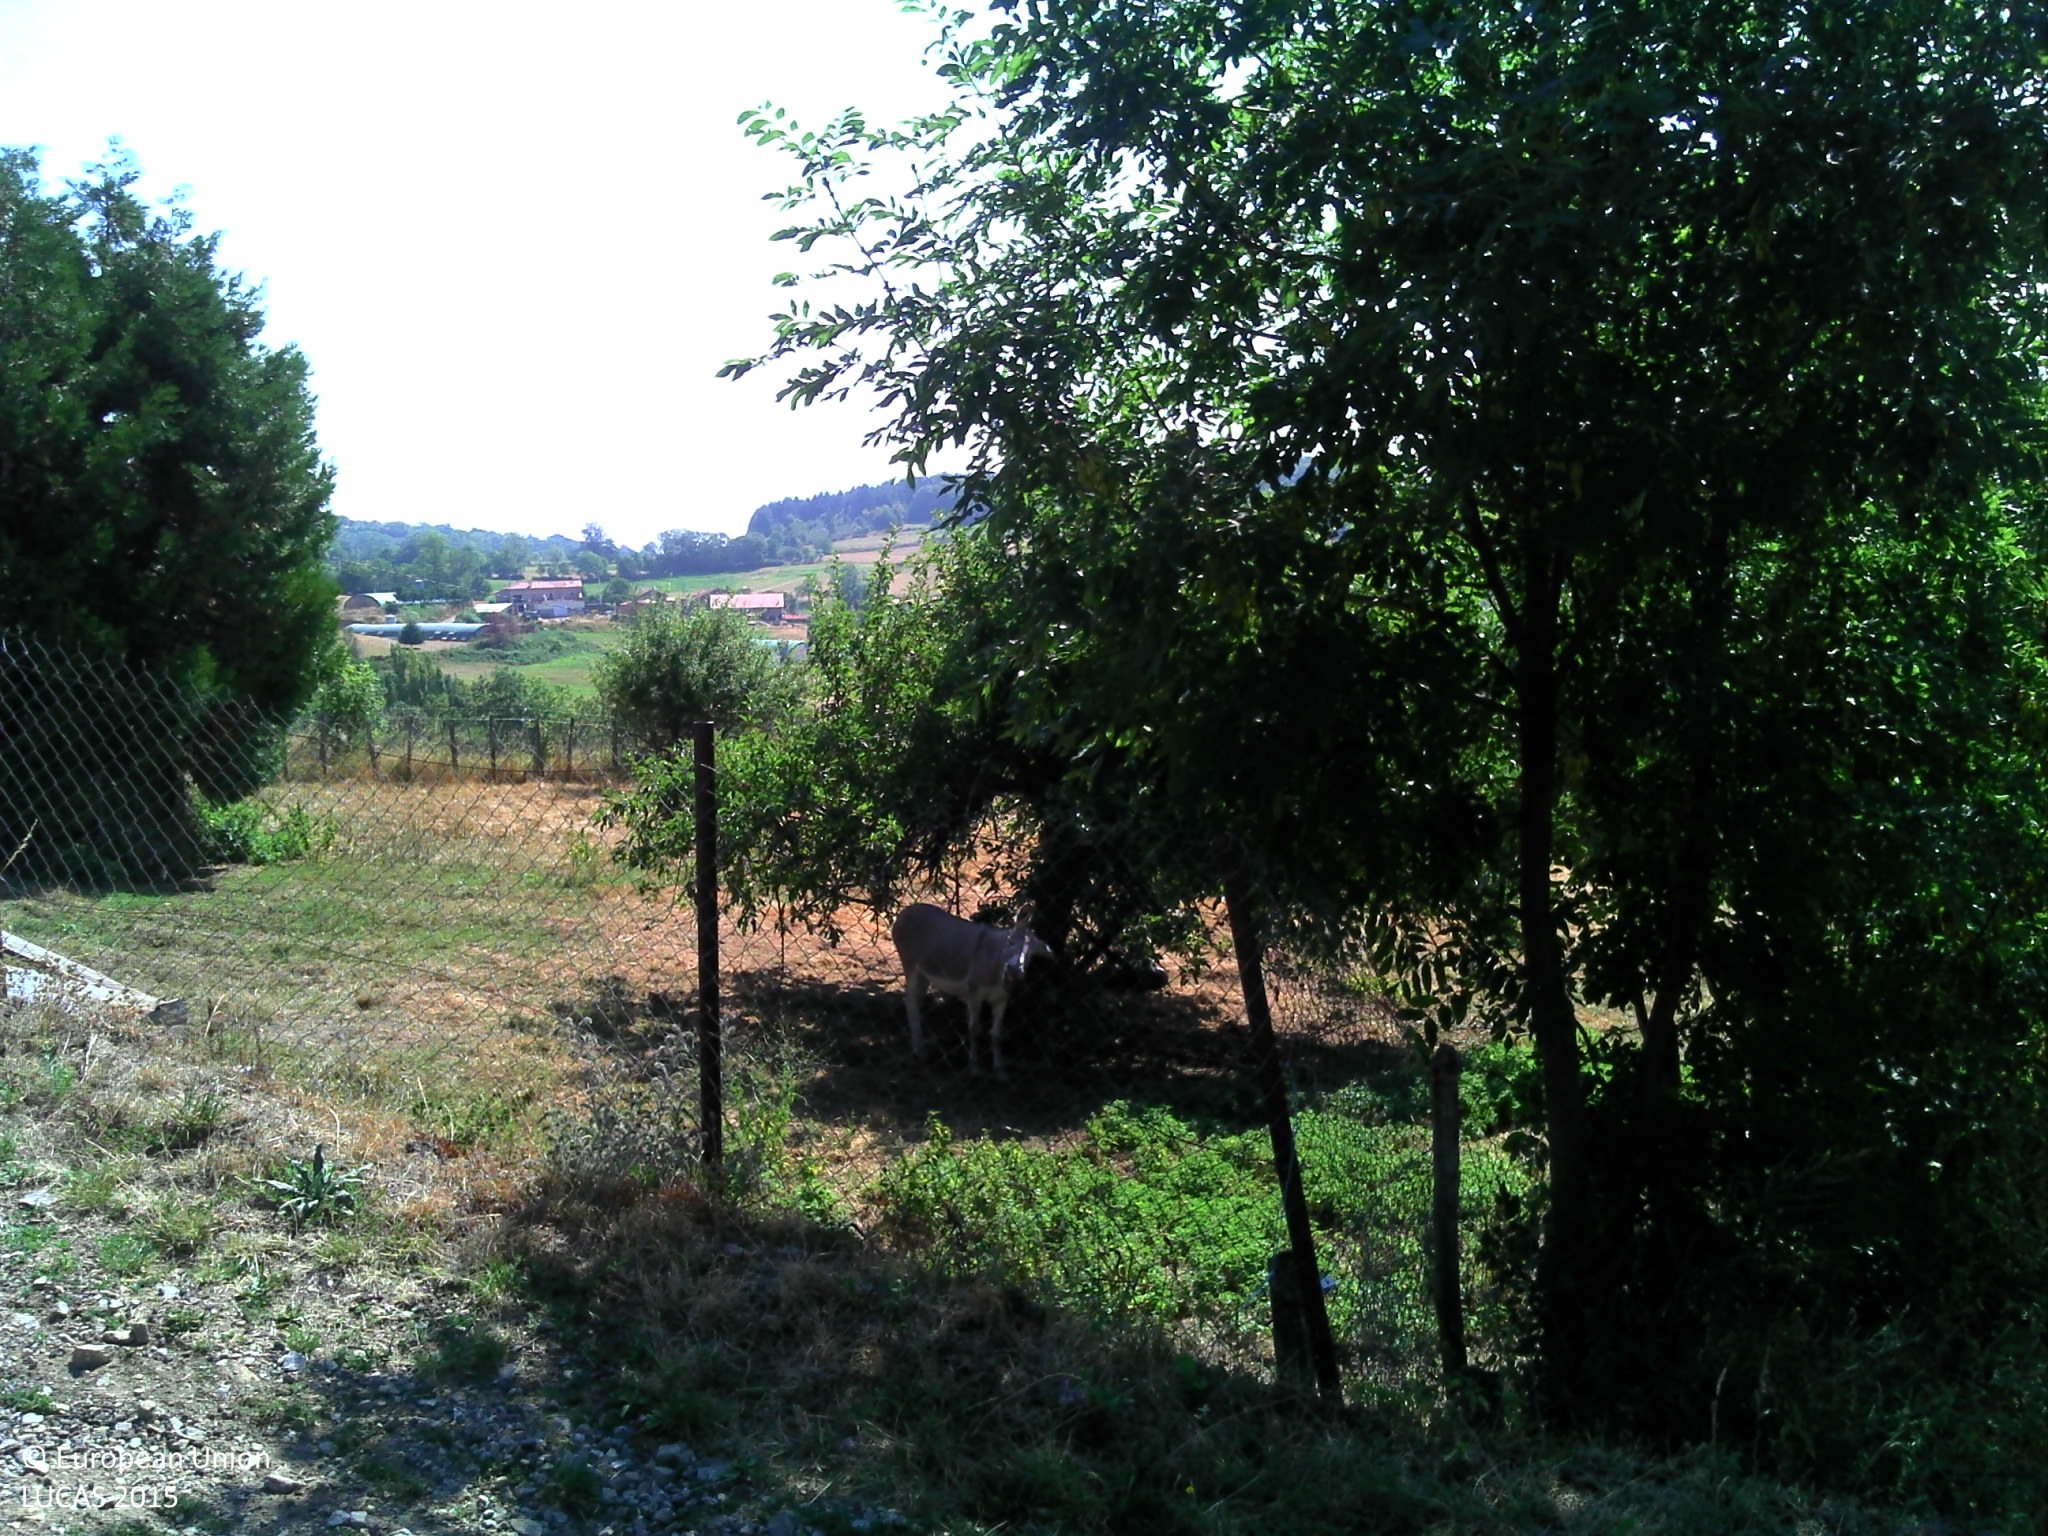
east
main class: Grassland
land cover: Grassland without tree/shrub cover
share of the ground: > 75 %
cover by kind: herbaceous plants 95 %, unconsolidated bare surface 5 %
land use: Semi-natural and natural areas not in use
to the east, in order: Grassland without tree/shrub cover; Tracks; Fences; Grassland with sparse tree/shrub cover; Fences; Grassland without tree/shrub cover; Electric lines; Grassland without tree/shrub cover; Fences; Lines of trees; Grassland without tree/shrub cover; Electric lines; Grassland without tree/shrub cover; Electric lines; Grassland without tree/shrub cover; Rivers and streams; Fences; Broadleaved woodland; Grassland with sparse tree/shrub cover
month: August
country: FR
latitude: 45.3484
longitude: 4.6054
